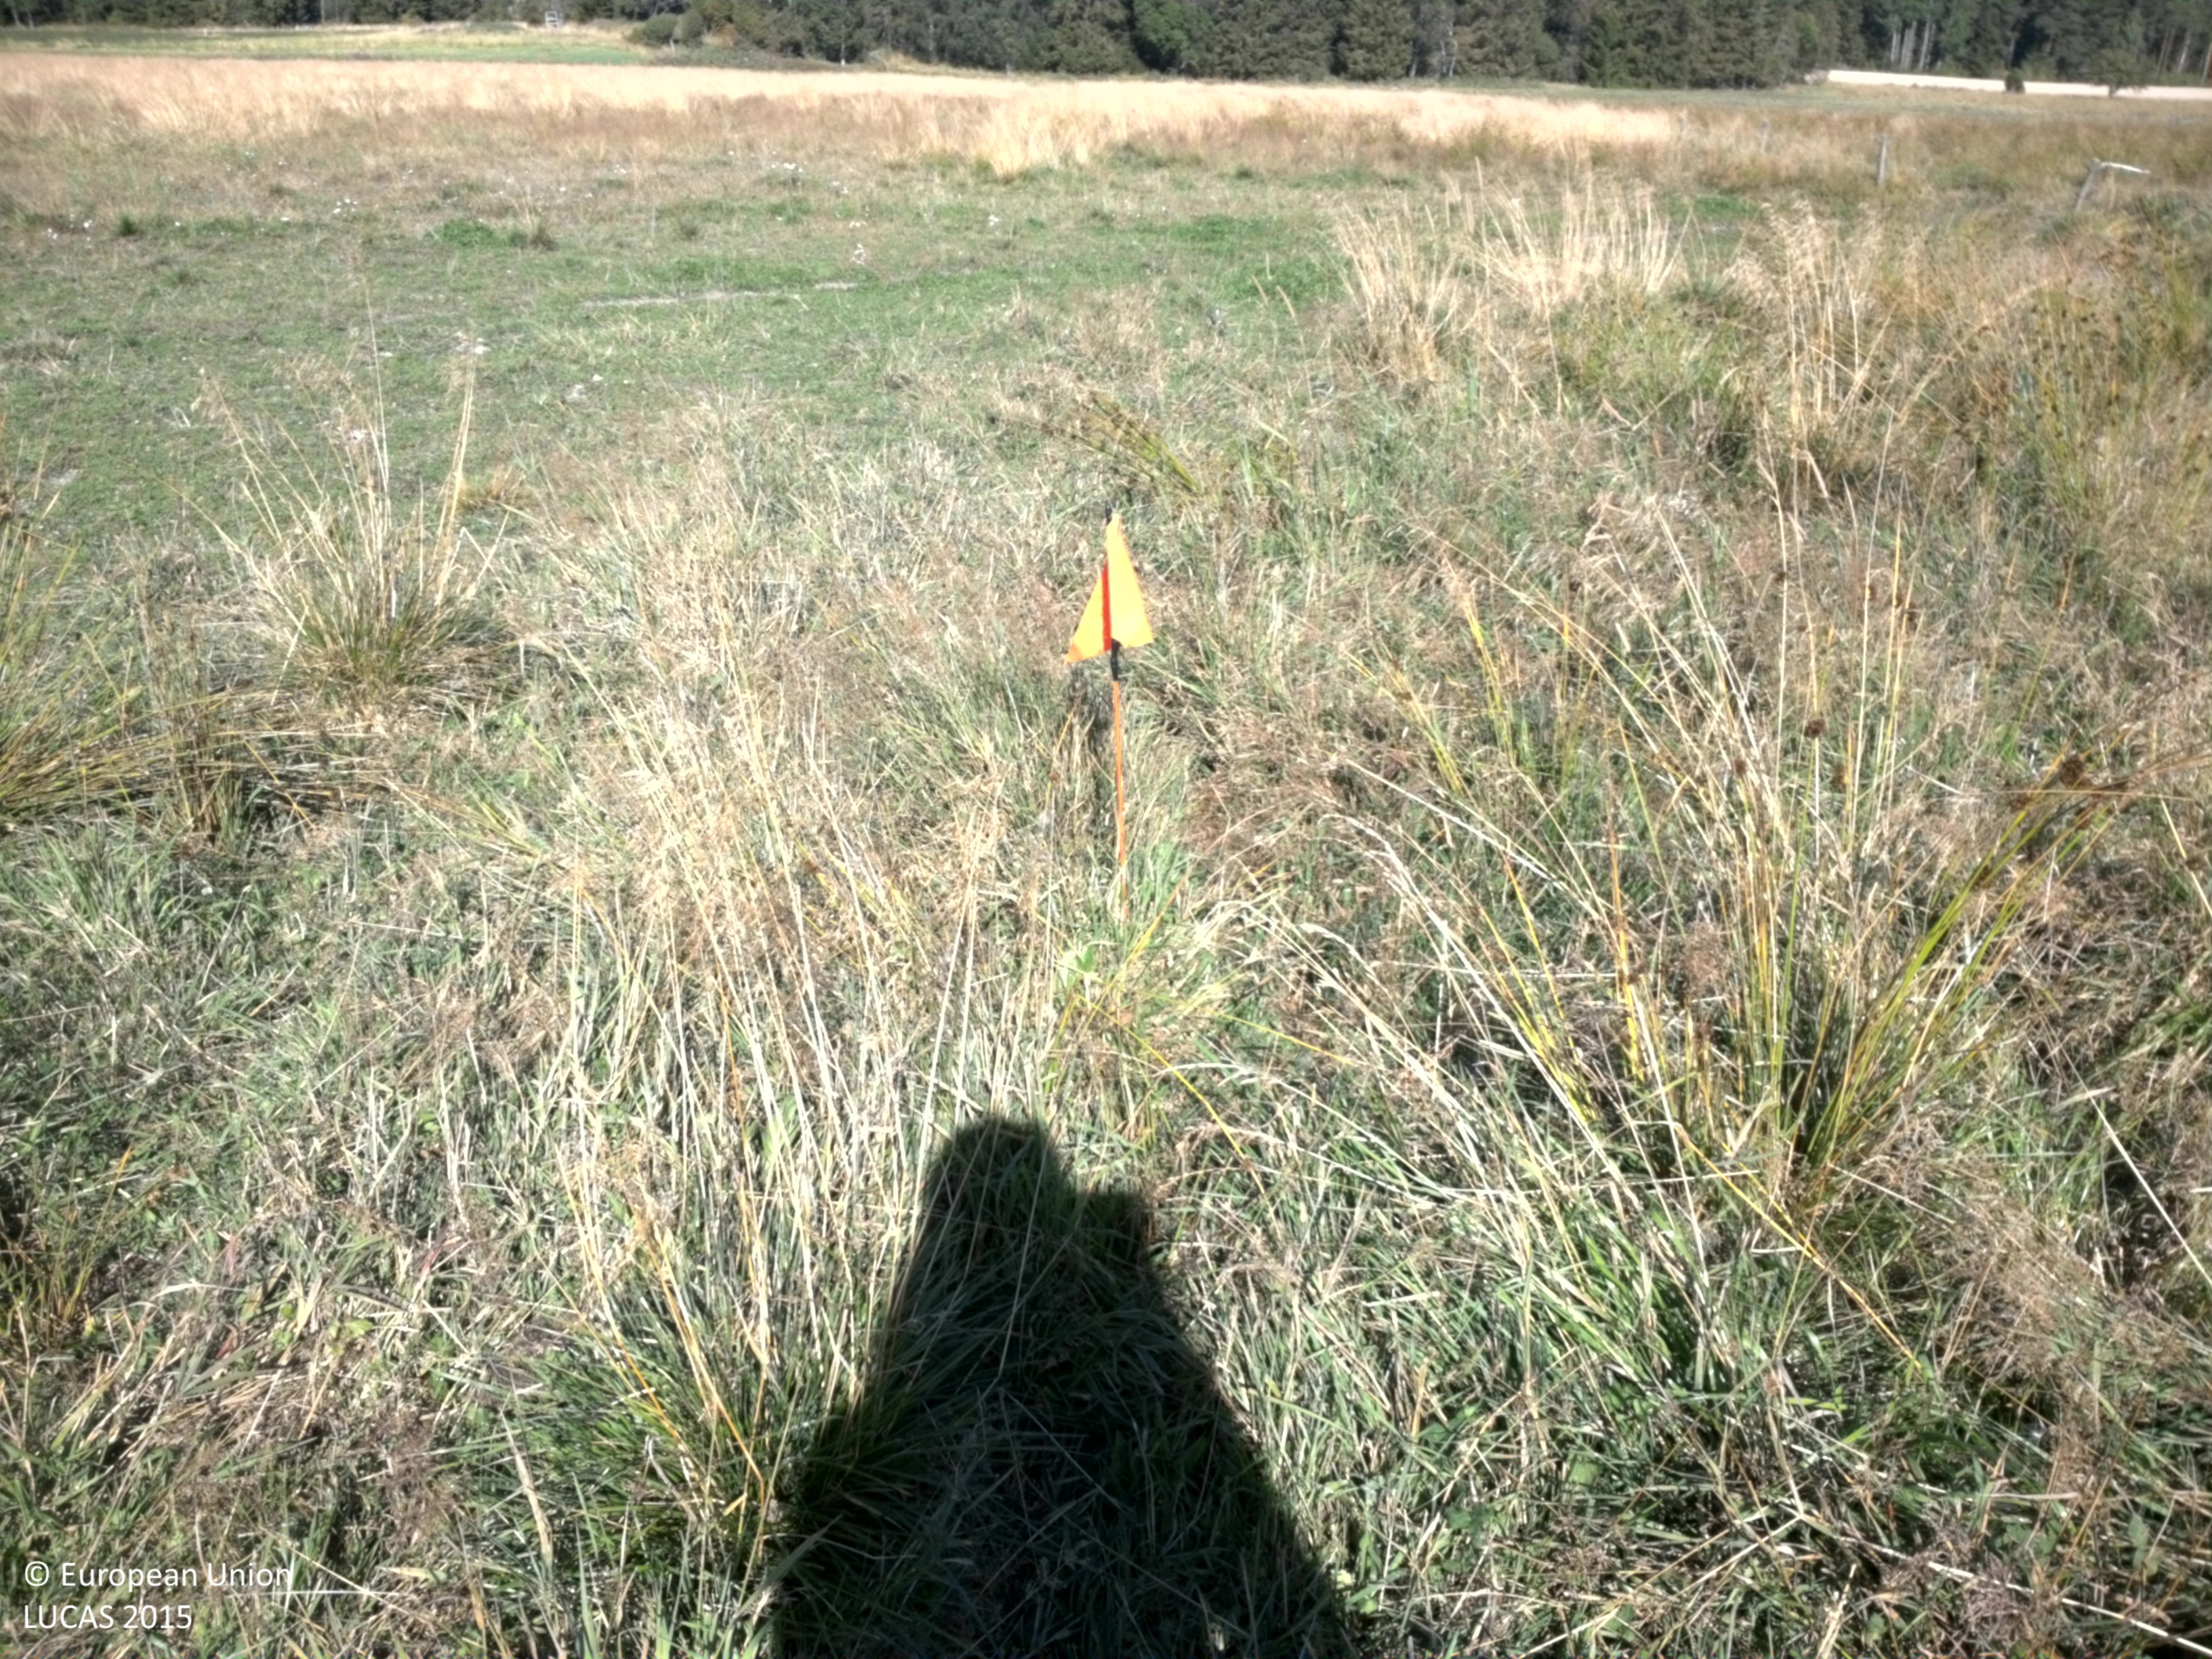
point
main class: Grassland
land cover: Grassland without tree/shrub cover
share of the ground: > 75 %
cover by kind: herbaceous plants 100 %
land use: Agriculture (excluding fallow land and kitchen gardens)
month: August
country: SE
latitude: 59.7937
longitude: 16.9241
